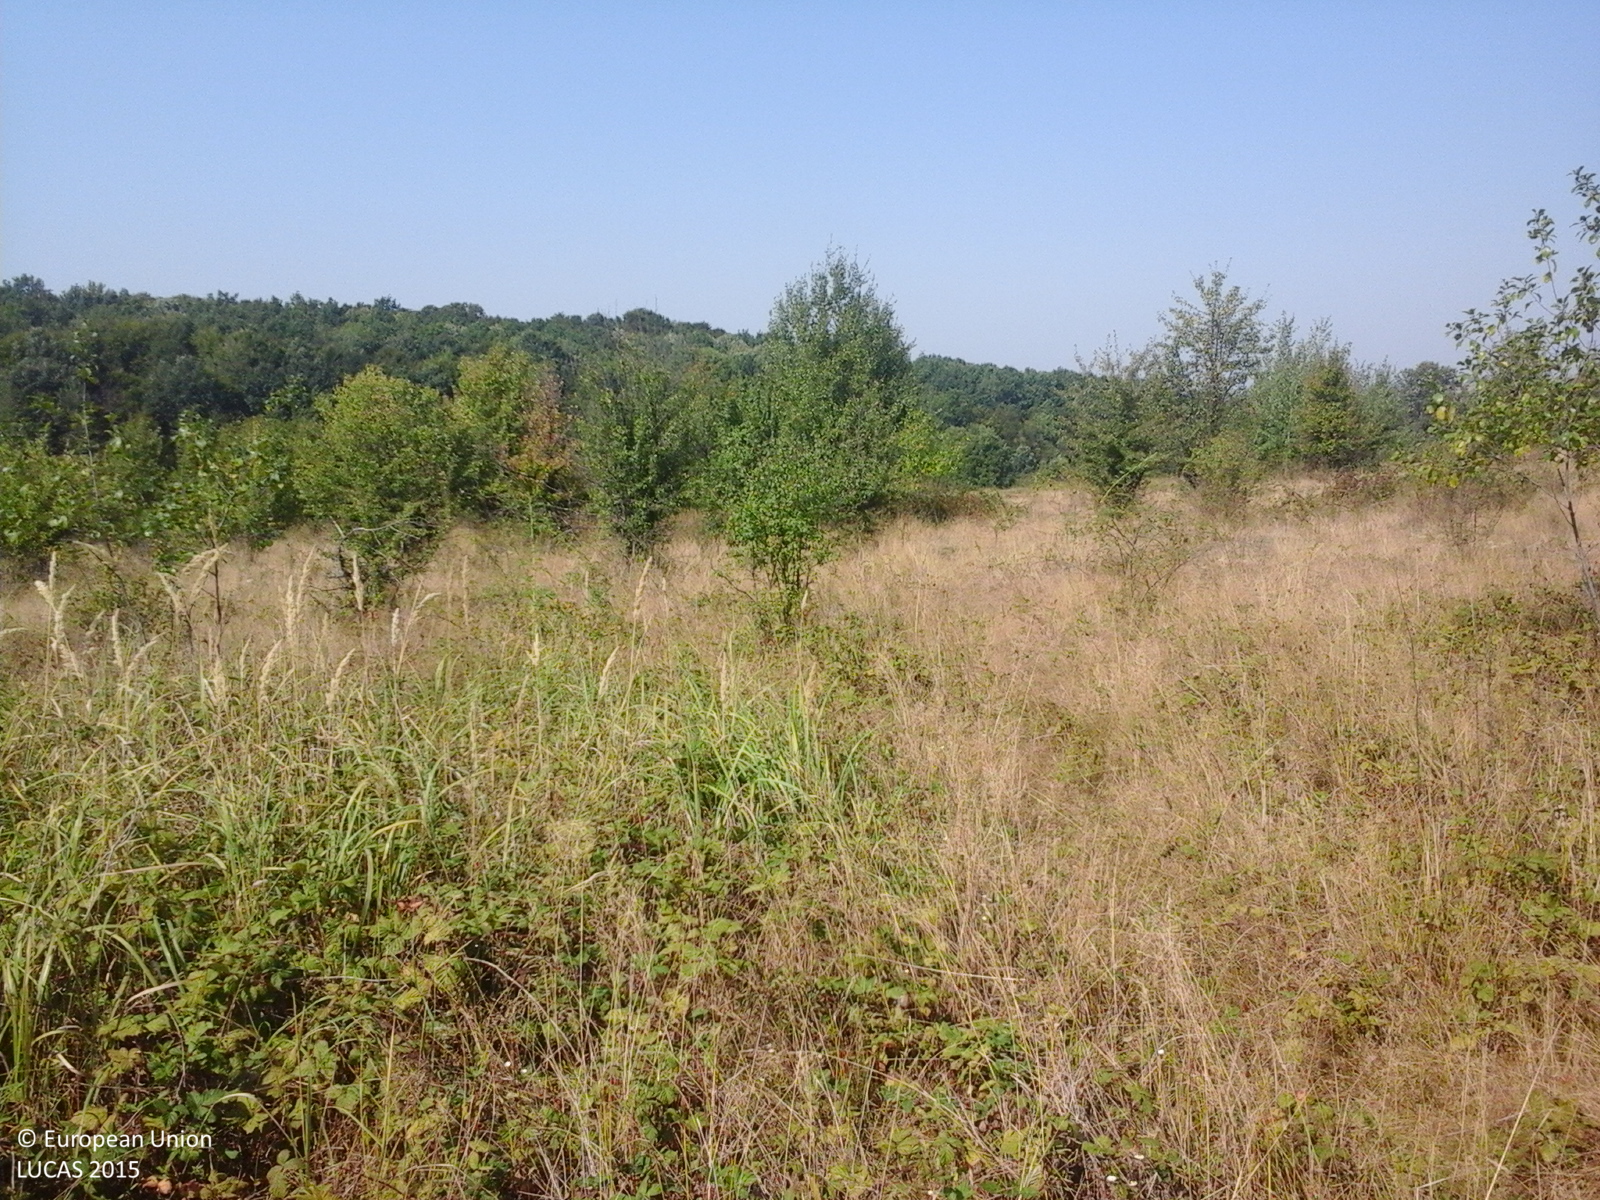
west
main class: Grassland
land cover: Grassland with sparse tree/shrub cover
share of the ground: > 75 %
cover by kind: herbaceous plants 85 %, shrubs 10 %, broadleaved forest trees 5 %
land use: Fallow land
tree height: < 5 m
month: August
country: RO
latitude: 46.3926
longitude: 22.2324
